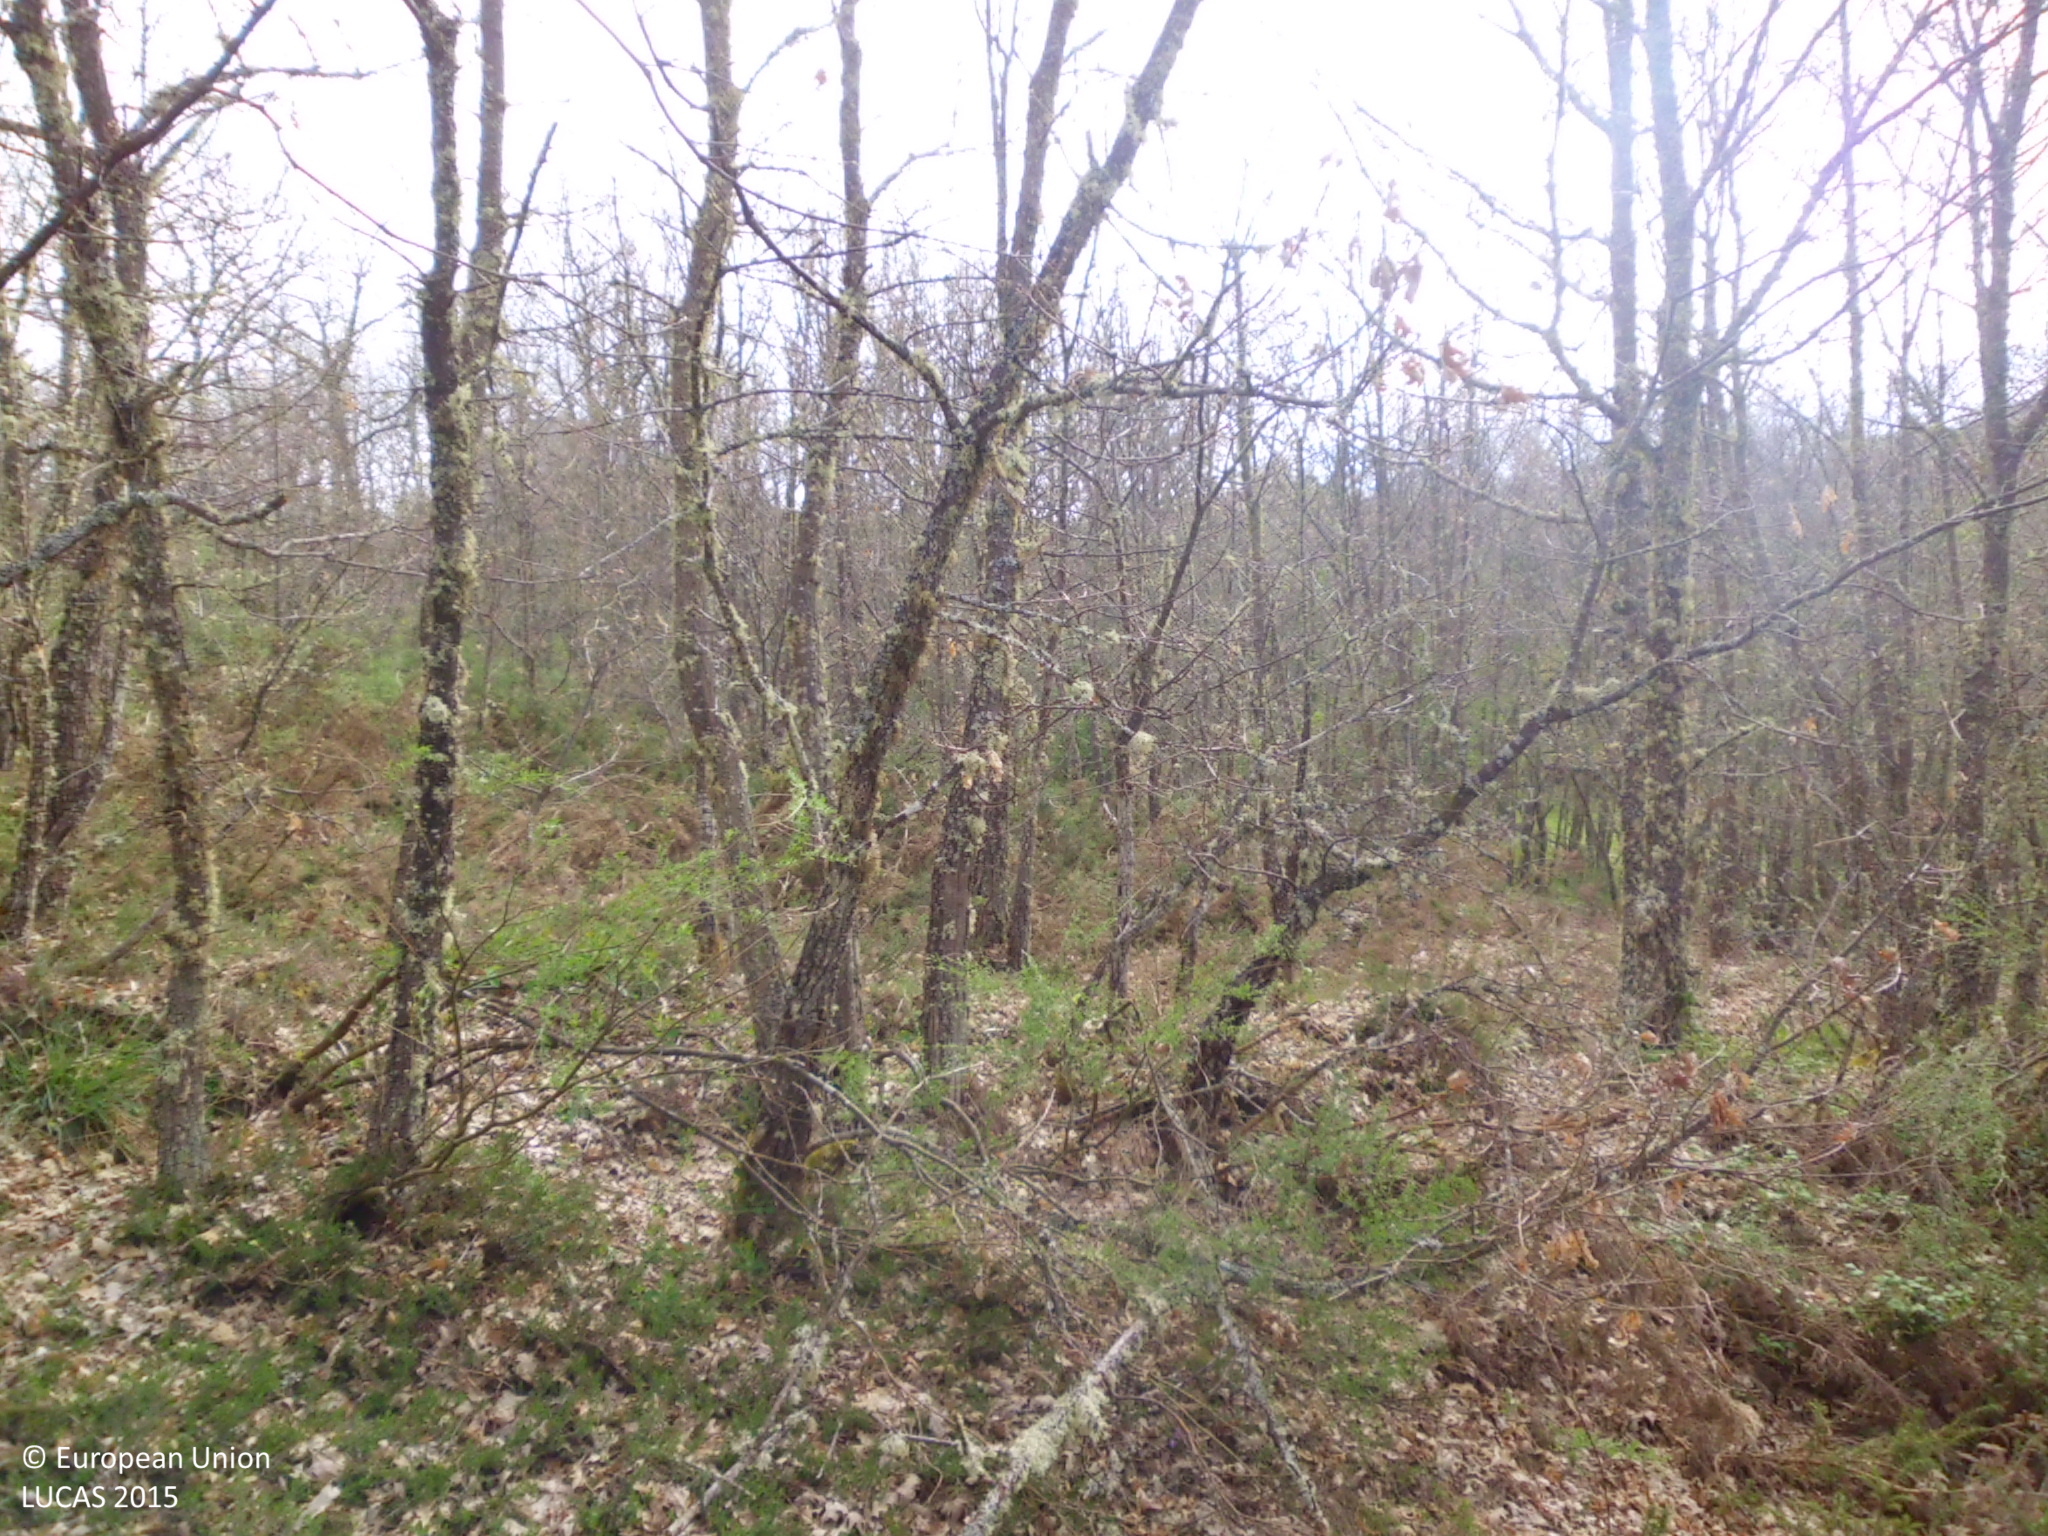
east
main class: Woodland
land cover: Broadleaved woodland
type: acidophilous oak and oak-birch forest
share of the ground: 50 - 75 %
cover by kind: broadleaved forest trees 70 %, herbaceous plants 20 %, shrubs 10 %
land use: Semi-natural and natural areas not in use
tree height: > 5 m
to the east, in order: Broadleaved woodland; Shrubland with sparse tree cover; Broadleaved woodland
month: May
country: ES
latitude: 42.9194
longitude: -3.8760
